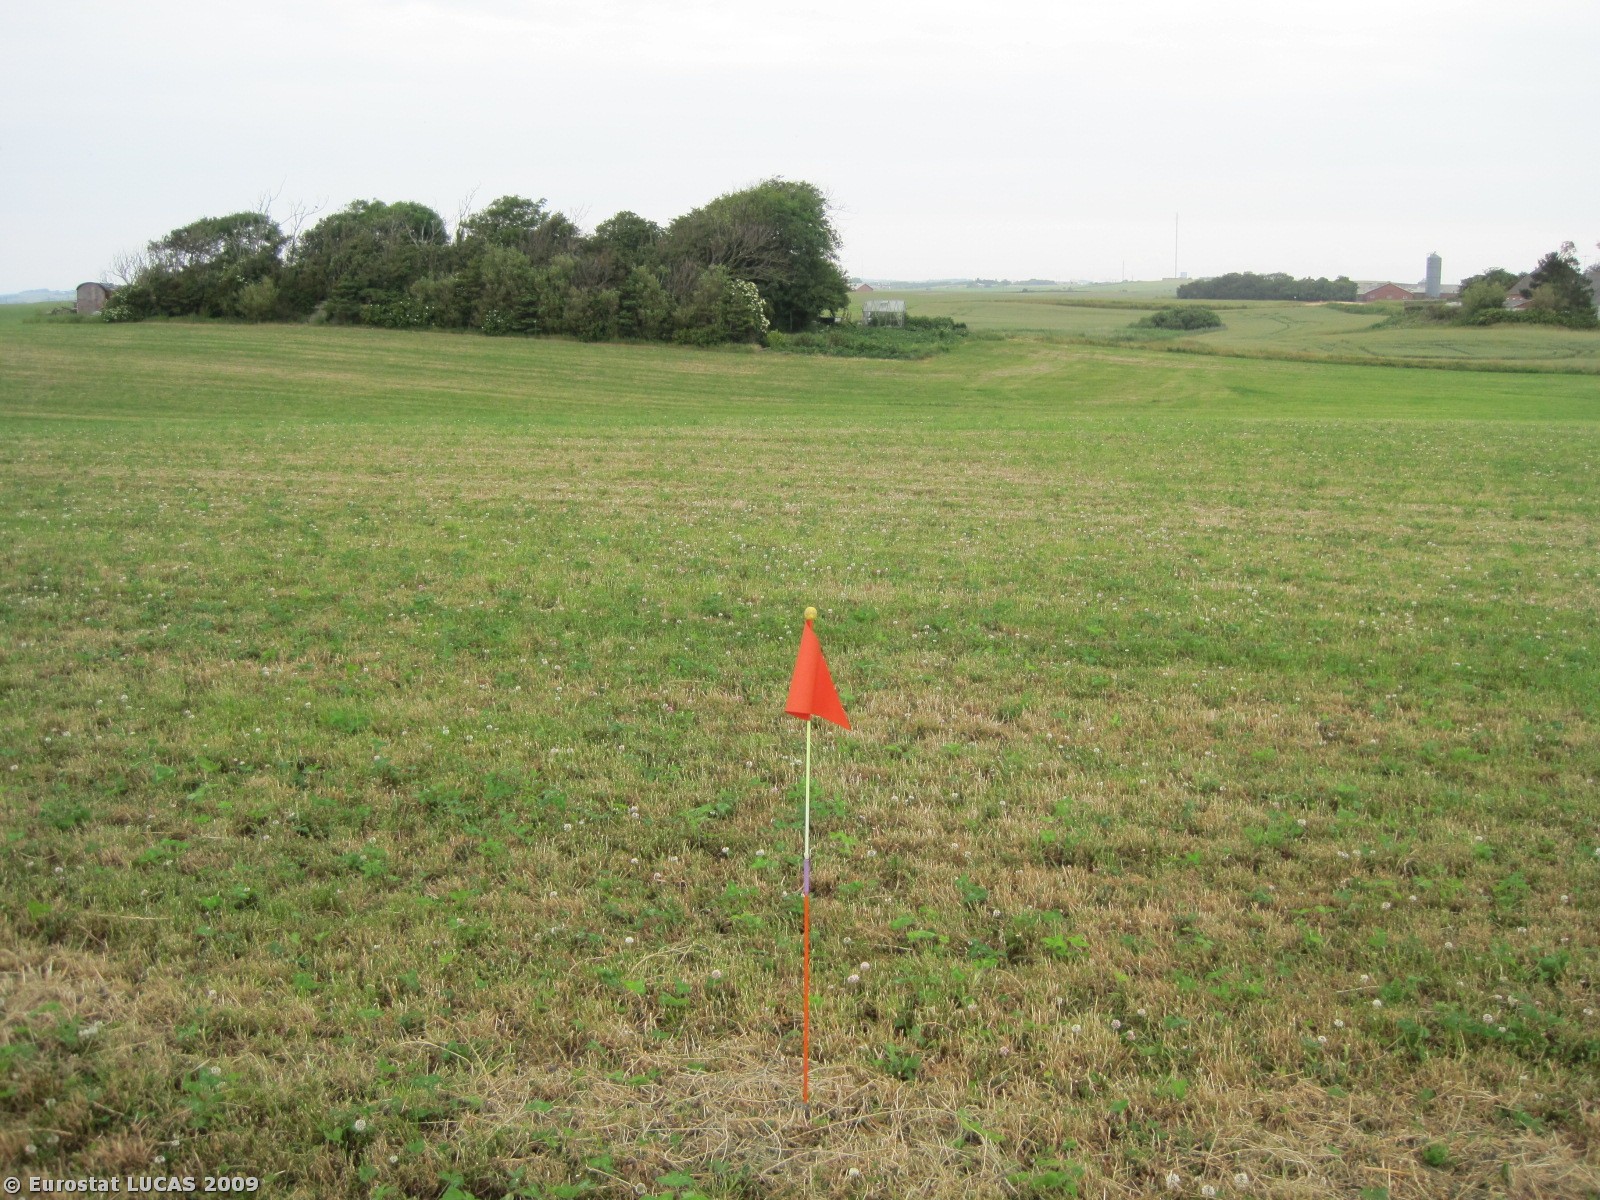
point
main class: Grassland
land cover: Grassland without tree/shrub cover
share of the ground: > 75 %
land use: Agriculture (excluding fallow land and kitchen gardens)
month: June
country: DK
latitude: 56.5356
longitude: 8.2622
